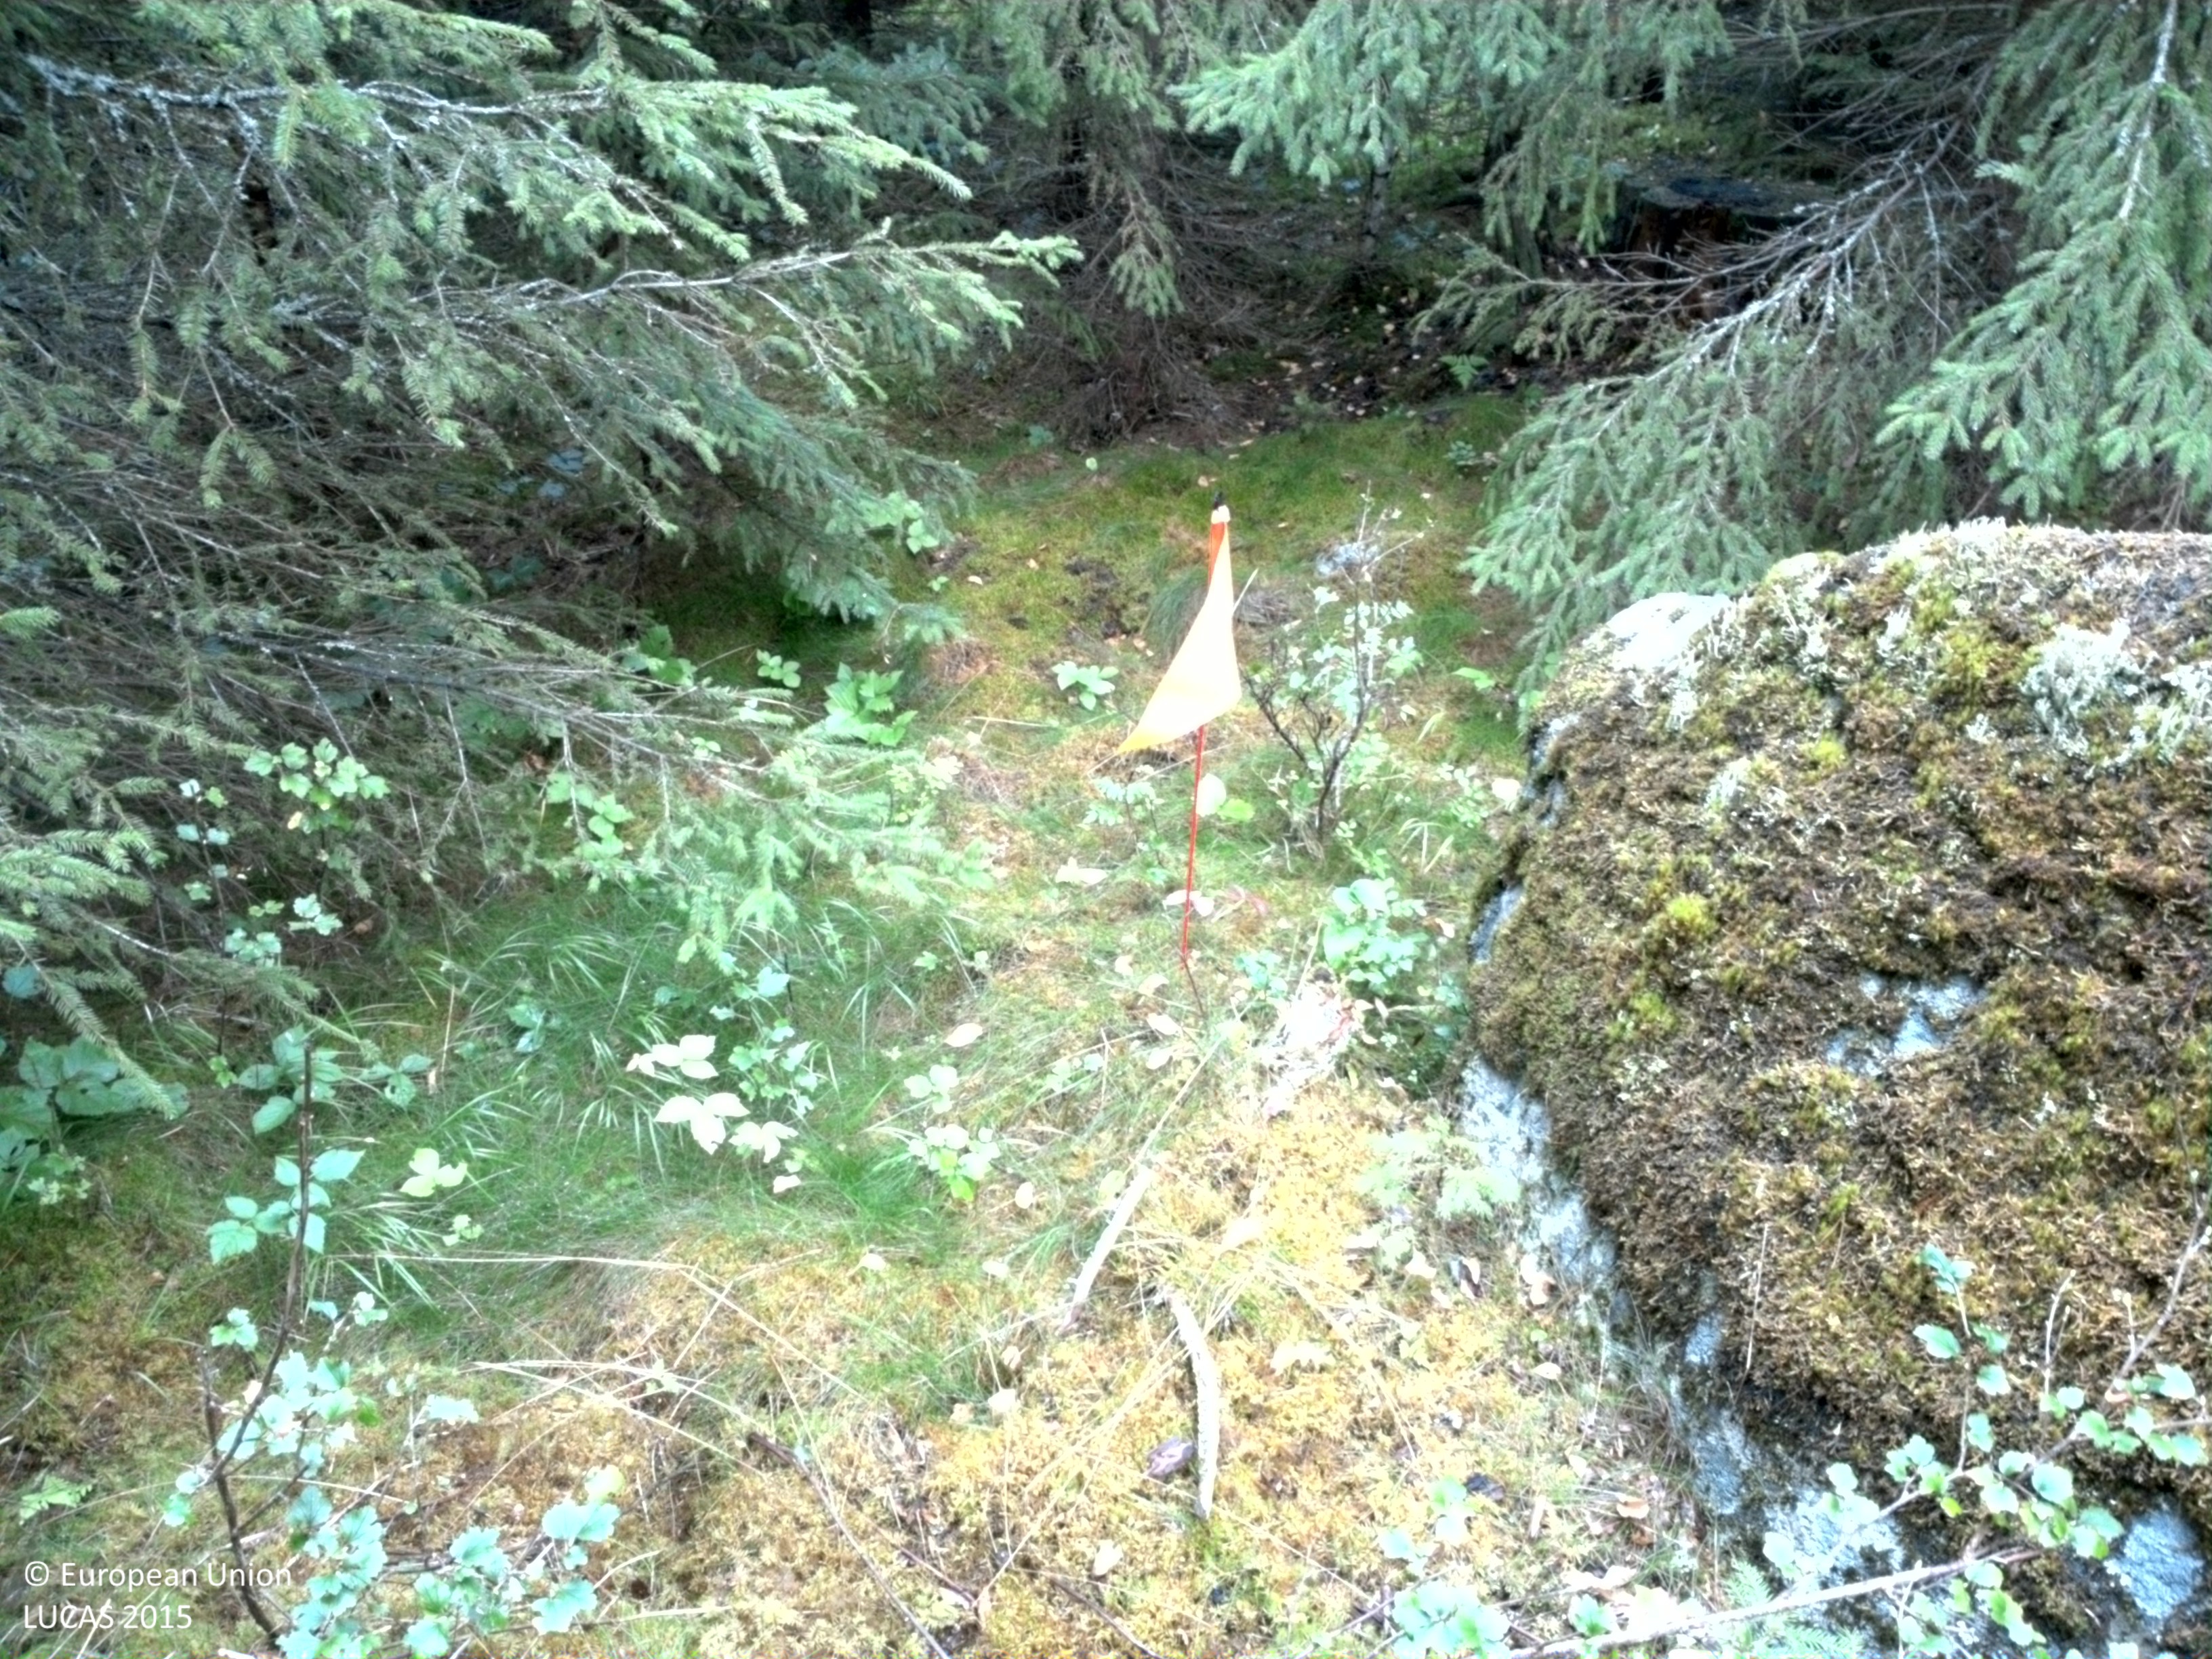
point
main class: Woodland
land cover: Spruce dominated coniferous woodland
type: boreal forest
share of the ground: > 75 %
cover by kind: coniferous forest trees 75 %, lichens and mosses 20 %, broadleaved forest trees 5 %
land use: Forestry
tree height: > 5 m
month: August
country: SE
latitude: 59.9892
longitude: 17.6835
